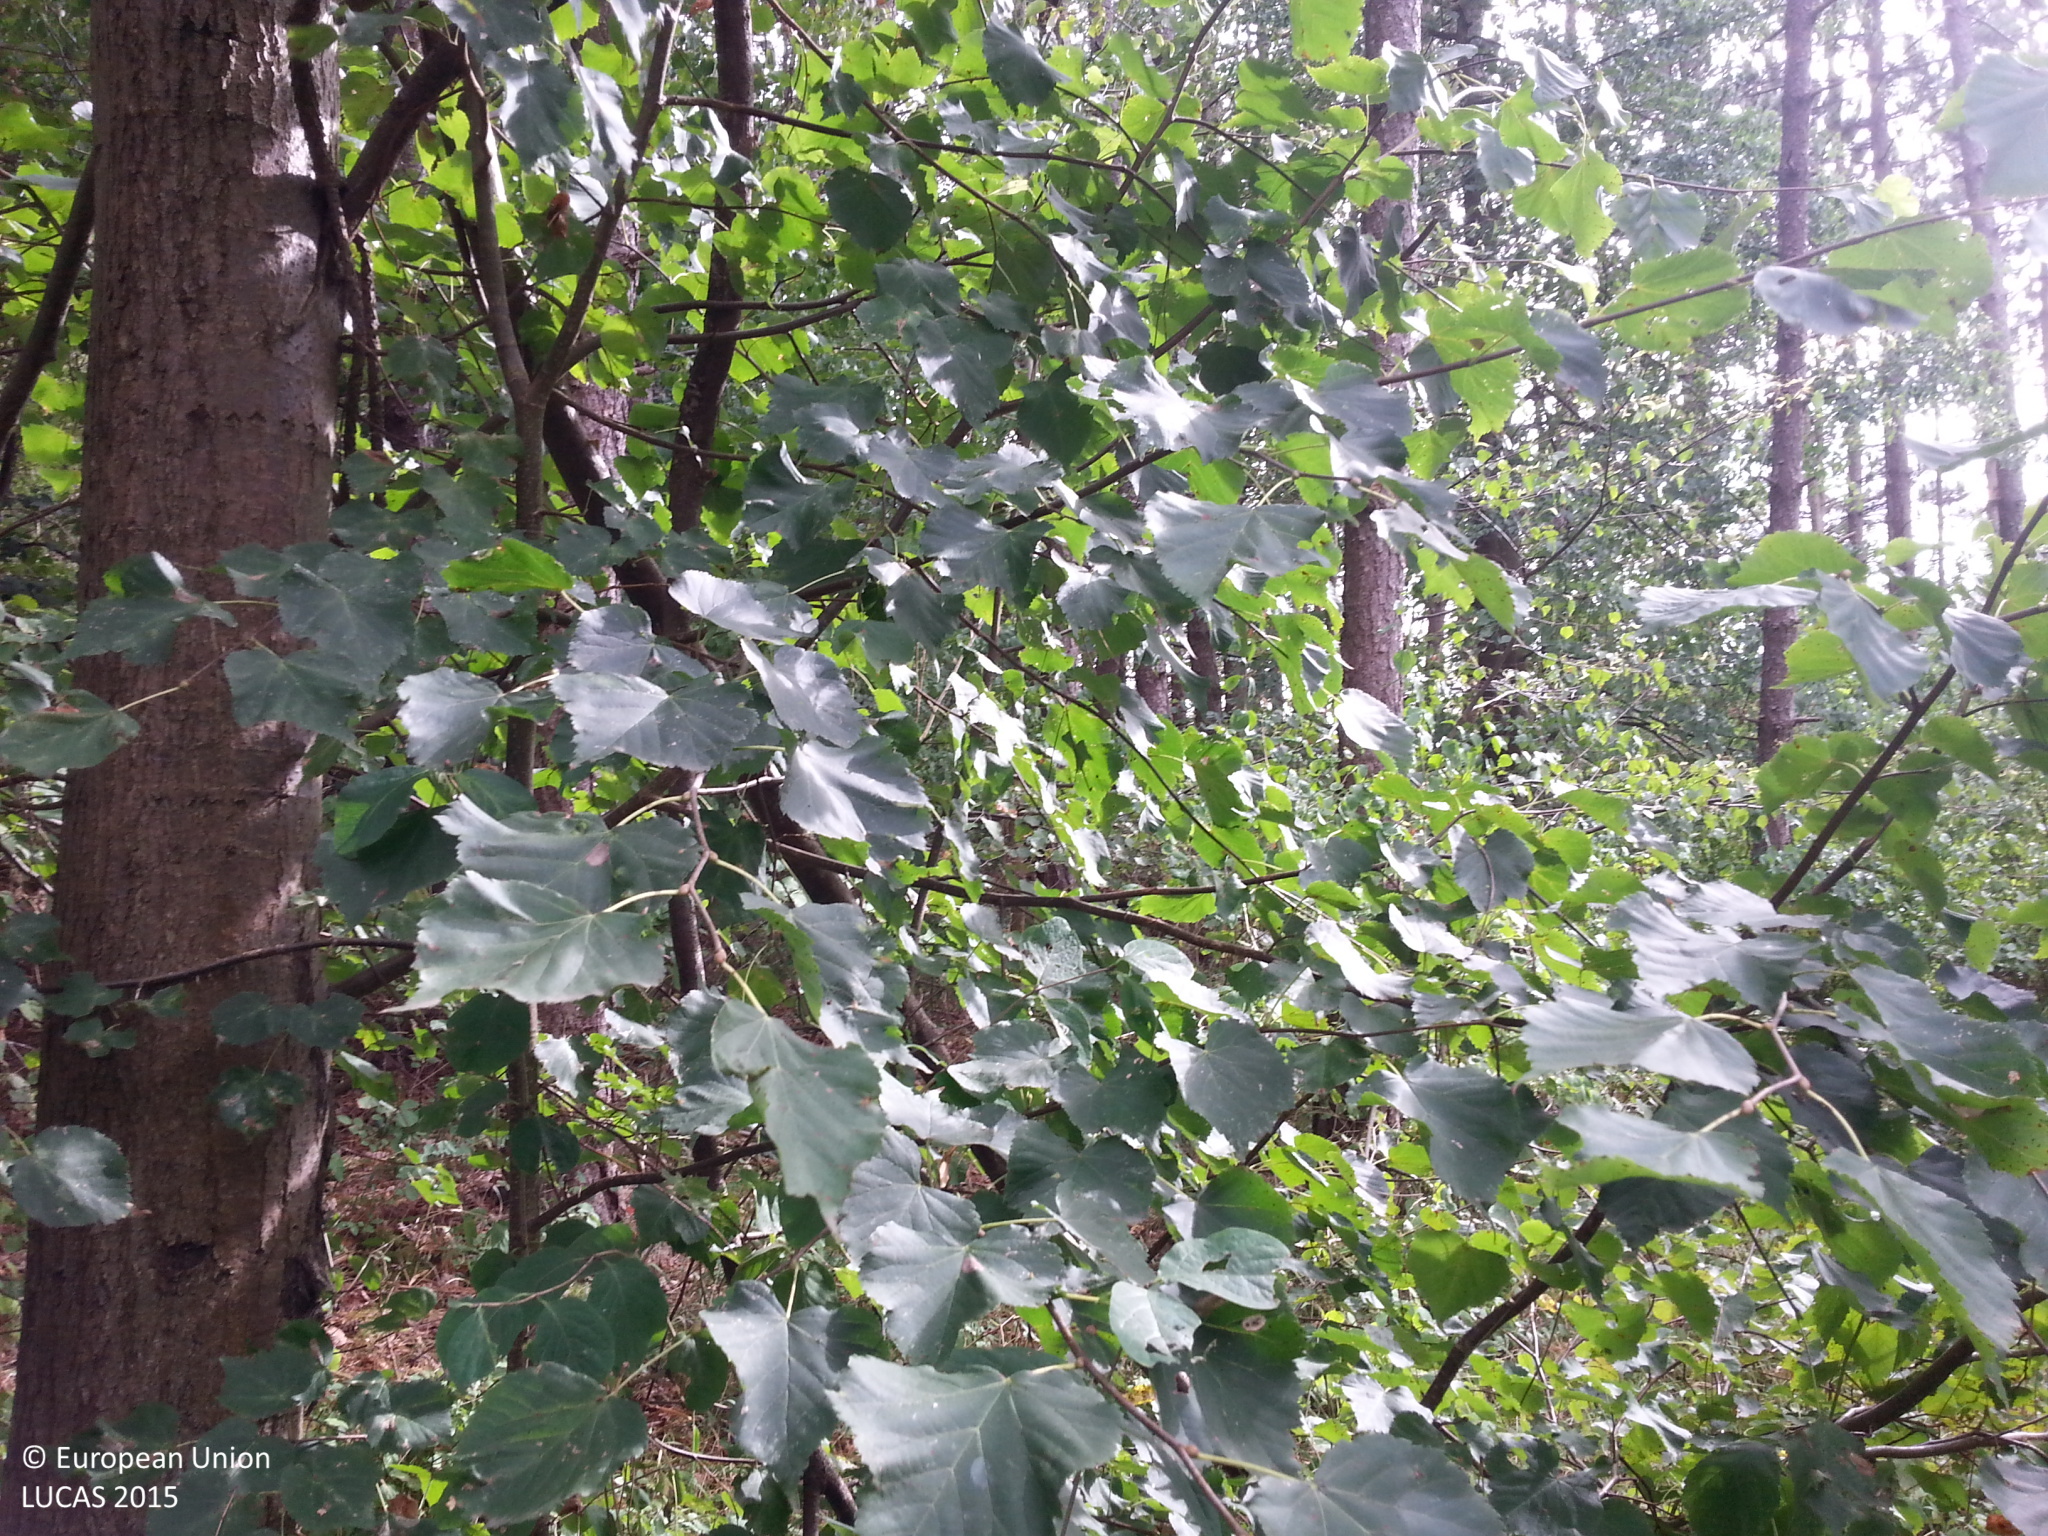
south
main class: Woodland
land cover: Pine dominated mixed woodland
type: hemiboreal forest and nemoral coniferous forest and mixed broadleaved-coniferous forest
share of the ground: 50 - 75 %
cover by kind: coniferous forest trees 40 %, broadleaved forest trees 30 %, shrubs 20 %, herbaceous plants 5 %, lichens and mosses 5 %
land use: Forestry
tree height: > 5 m
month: September
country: DE
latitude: 49.5900
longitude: 9.5713
